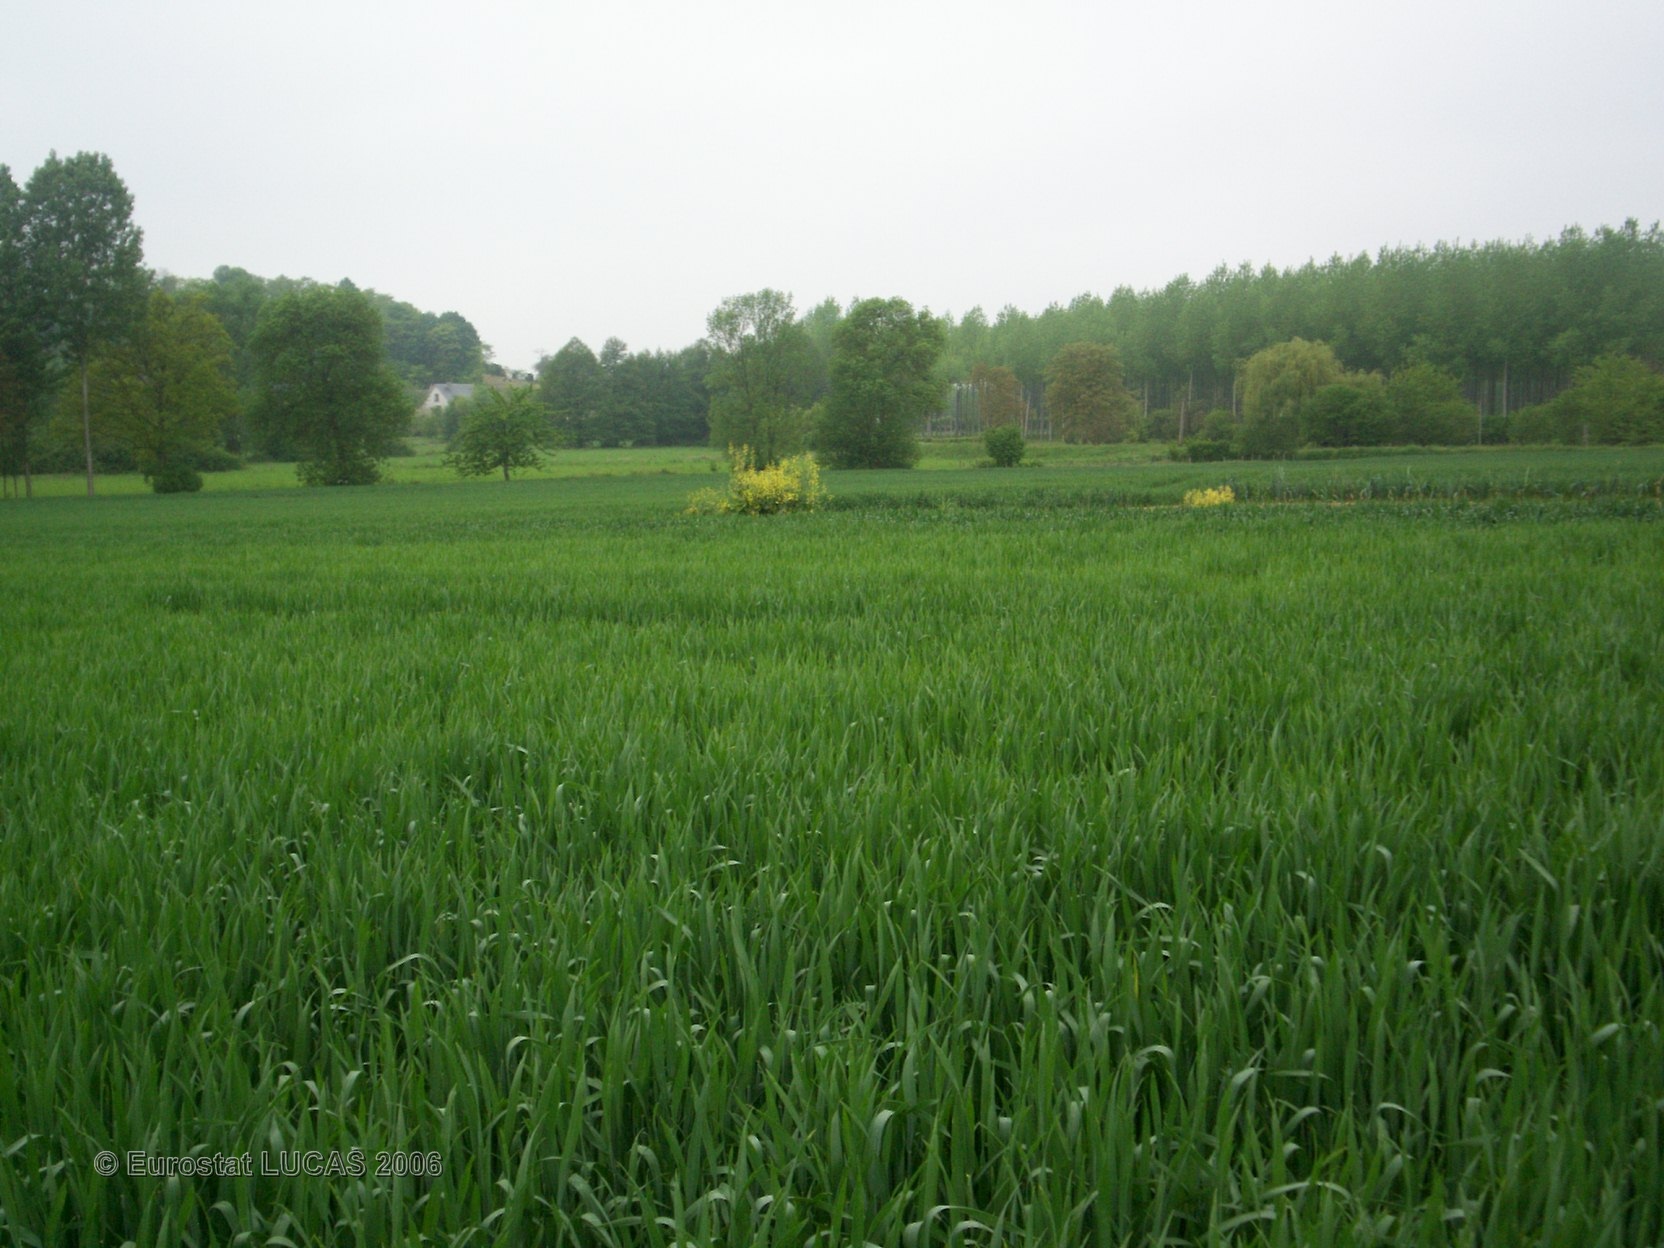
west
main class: Cropland
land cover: Common wheat
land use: Agriculture (excluding fallow land and kitchen gardens)
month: May
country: FR
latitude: 47.6660
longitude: 0.4827
